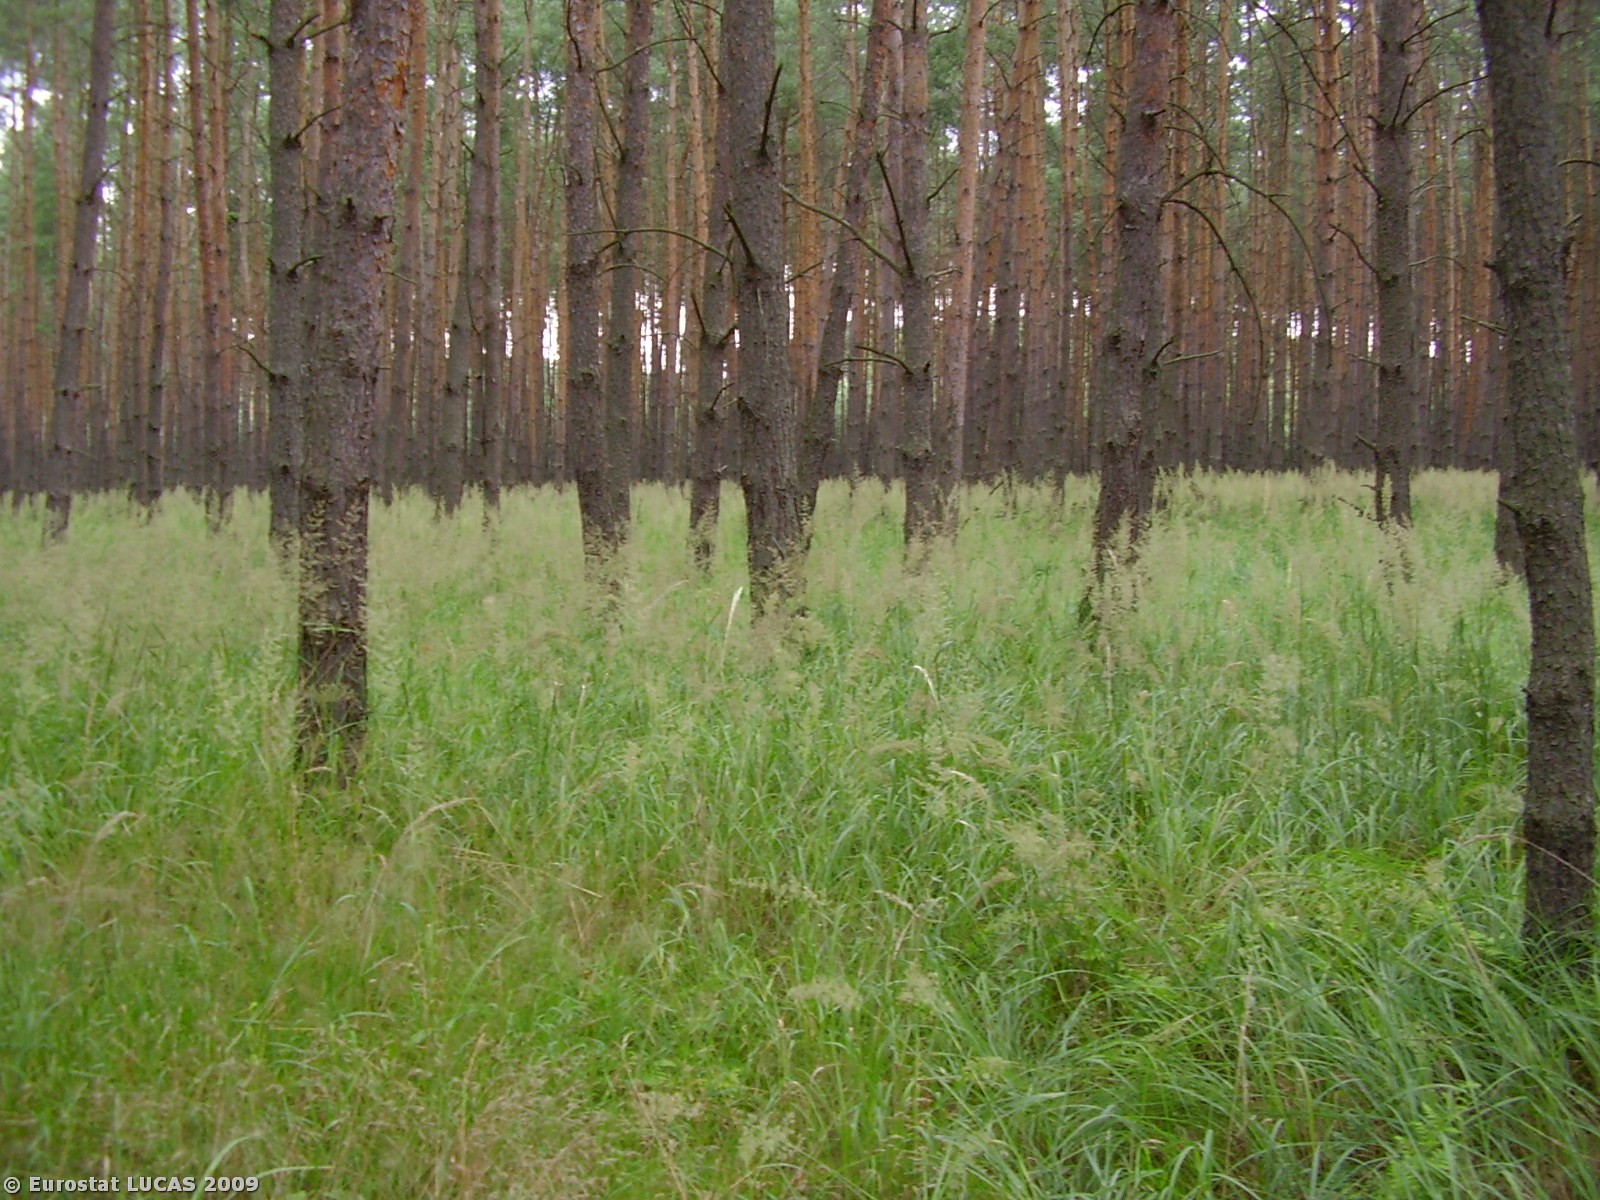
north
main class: Woodland
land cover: Coniferous woodland
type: hemiboreal forest and nemoral coniferous forest and mixed broadleaved-coniferous forest
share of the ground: > 75 %
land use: Forestry
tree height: > 5 m
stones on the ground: < 10 %
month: July
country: PL
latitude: 51.8499
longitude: 16.2928
